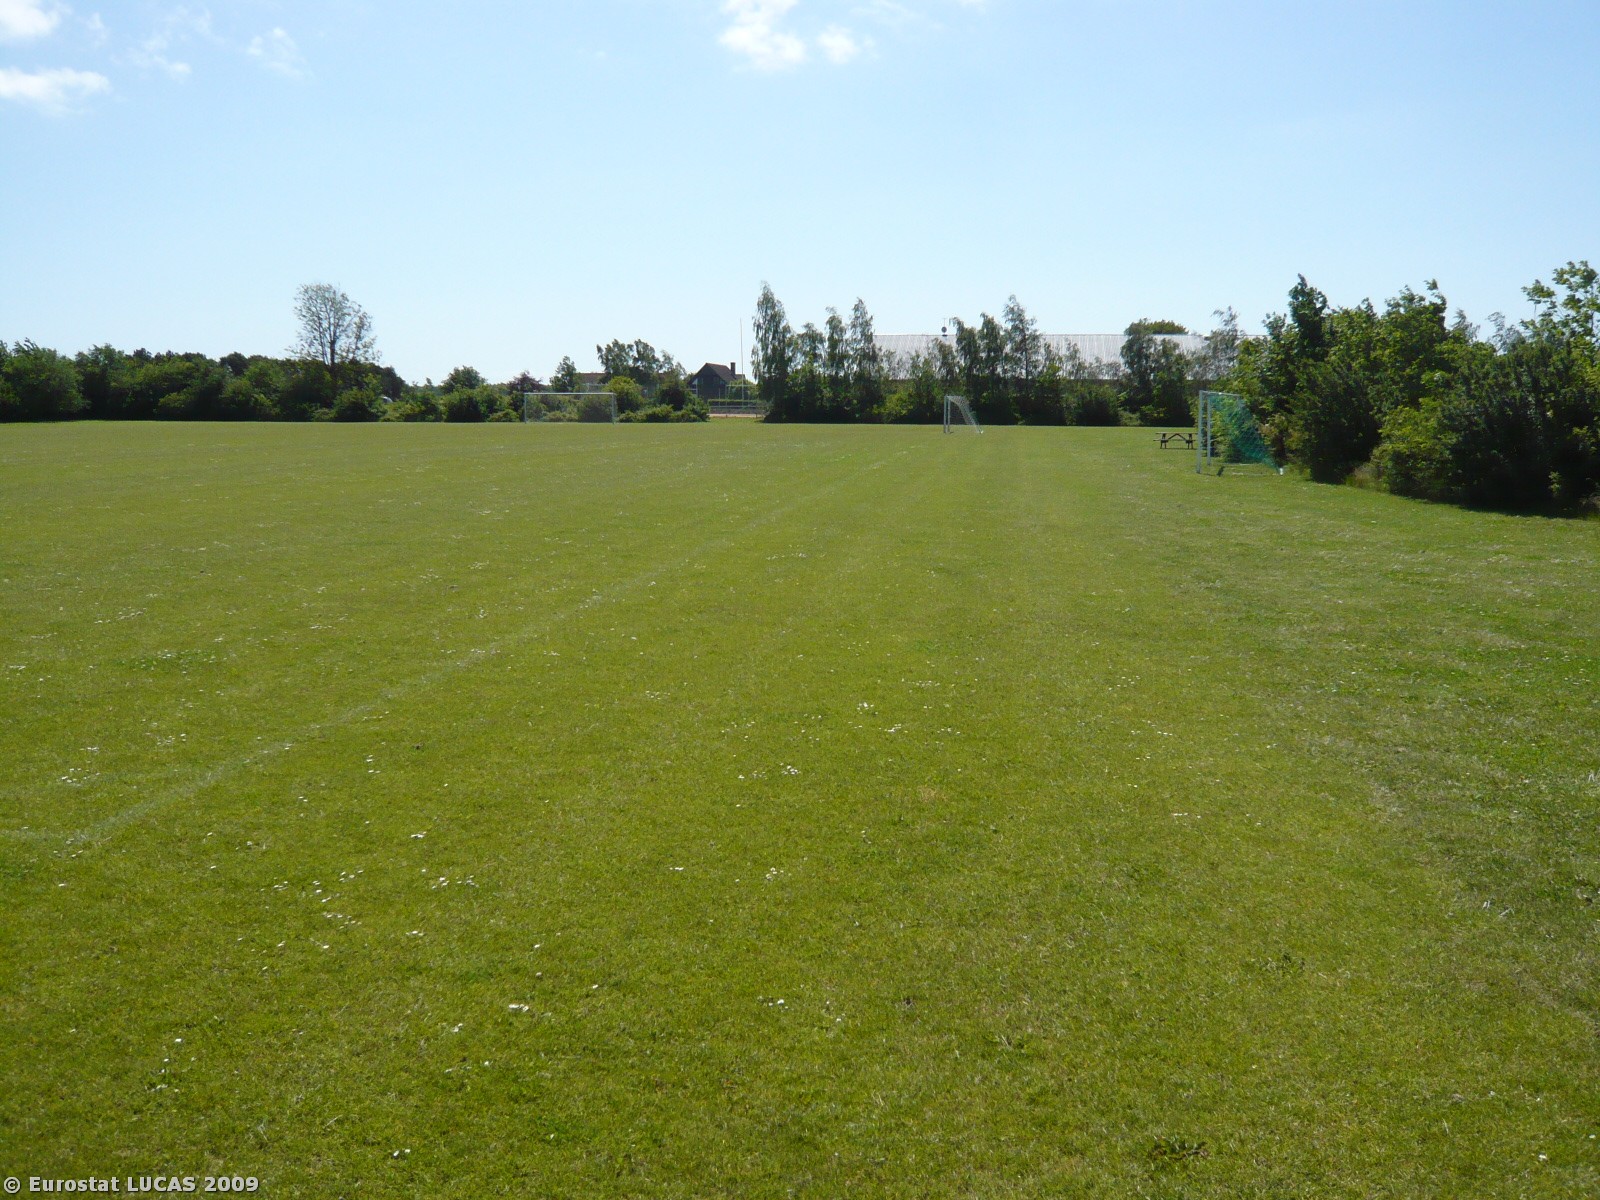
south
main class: Grassland
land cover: Grassland without tree/shrub cover
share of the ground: > 75 %
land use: Sport
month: June
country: DK
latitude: 54.7627
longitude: 11.1337
